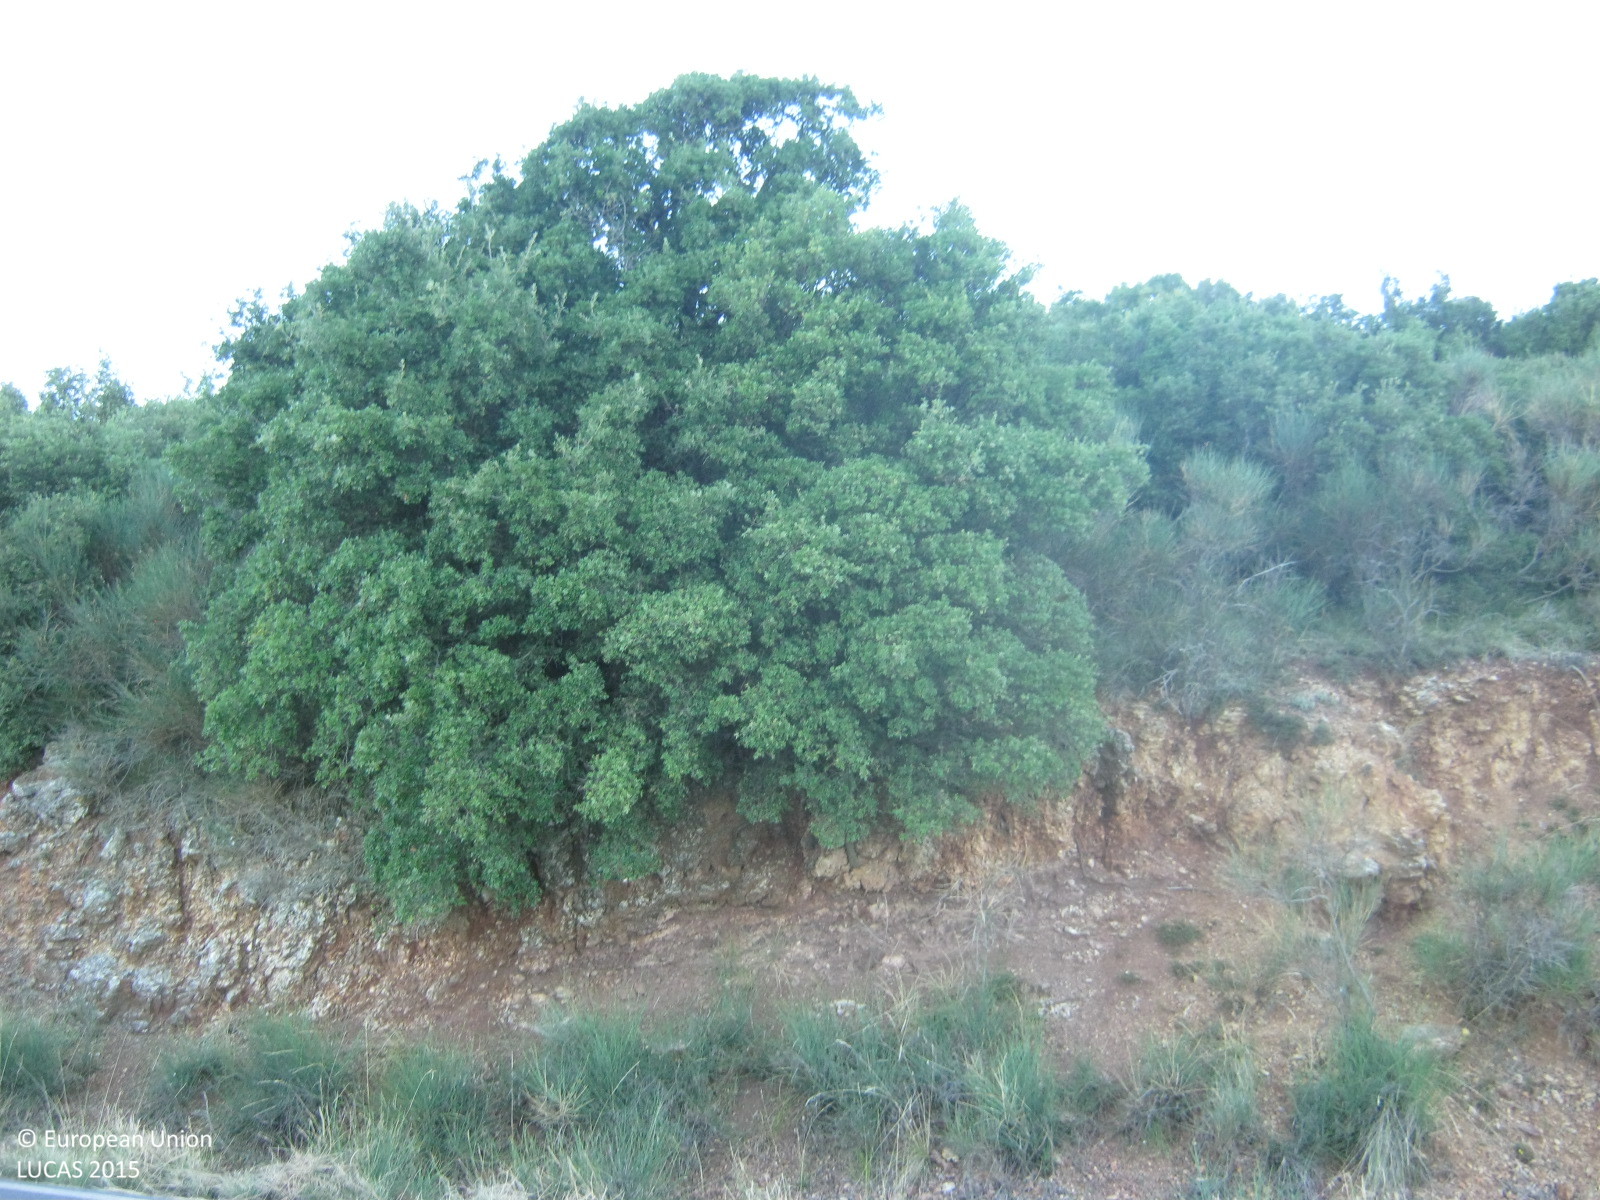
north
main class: Shrubland
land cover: Shrubland with sparse tree cover
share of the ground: > 75 %
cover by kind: shrubs 95 %, broadleaved forest trees 5 %
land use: Semi-natural and natural areas not in use
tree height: > 5 m
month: September
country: GR
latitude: 37.5920
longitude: 21.9767
